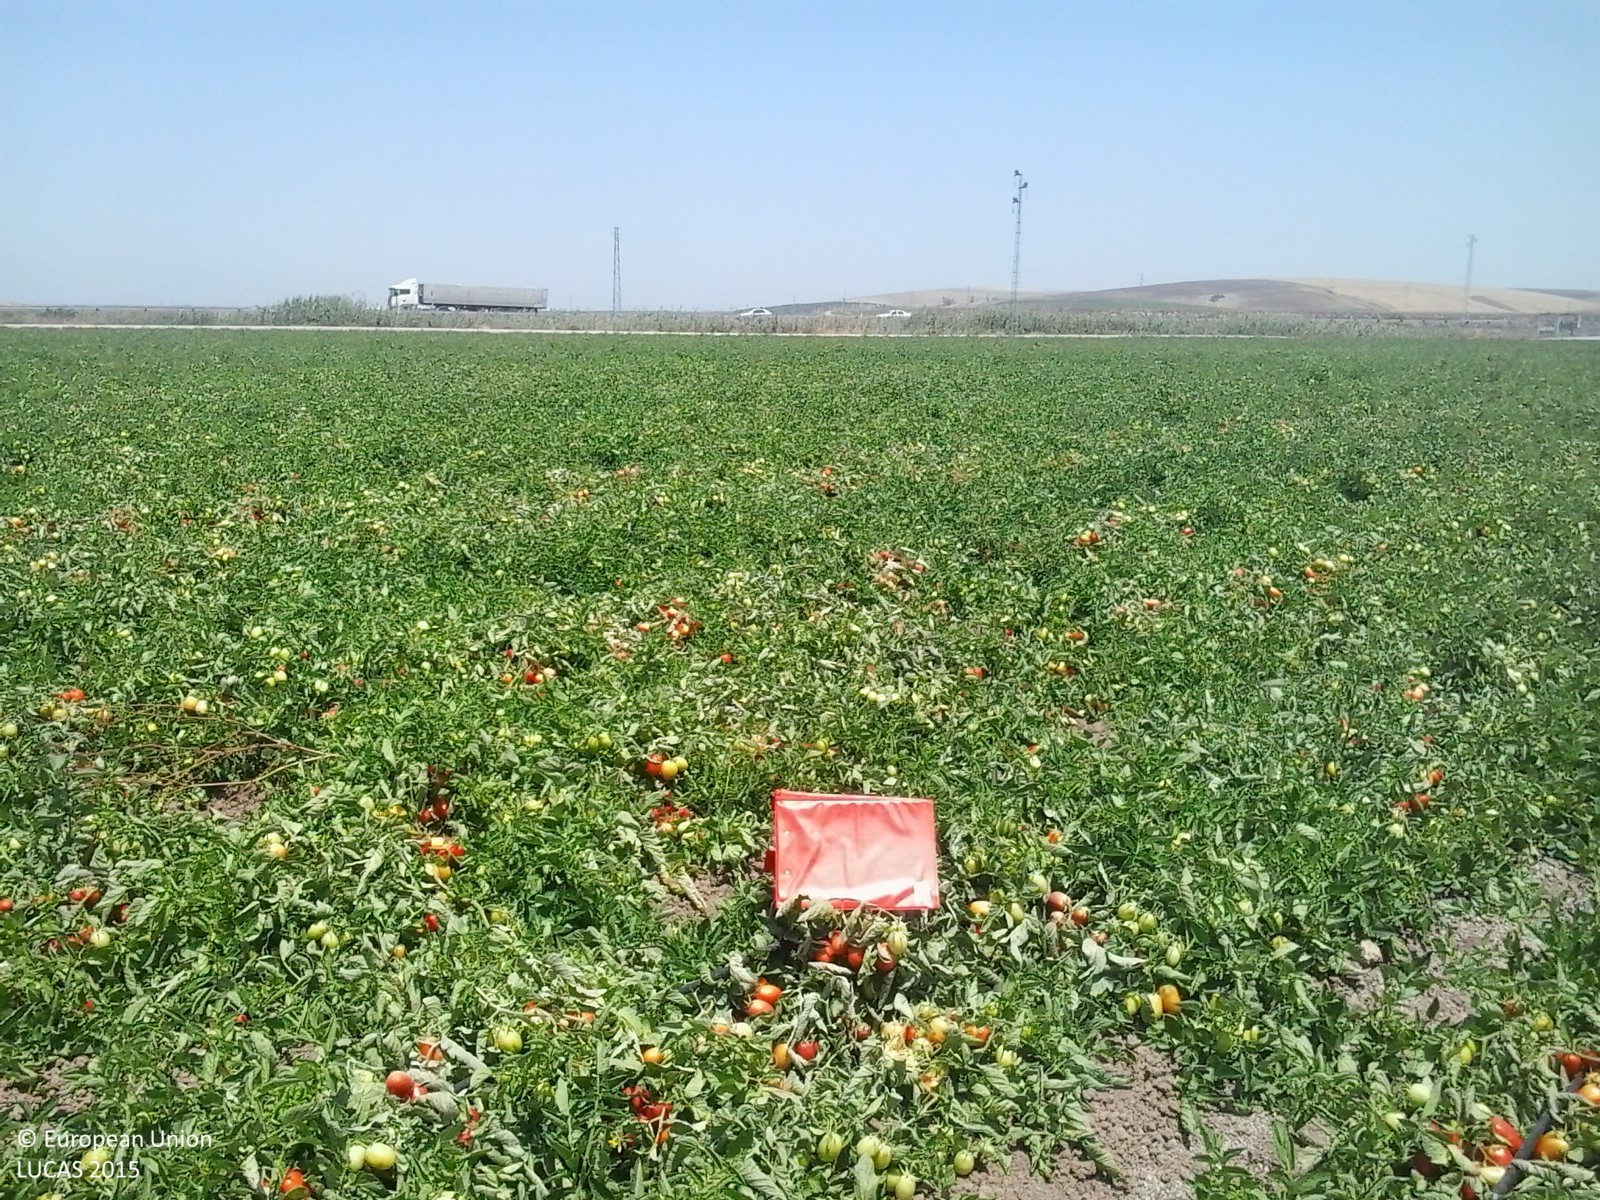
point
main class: Cropland
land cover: Tomatoes
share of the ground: > 75 %
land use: Agriculture (excluding fallow land and kitchen gardens)
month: July
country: ES
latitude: 36.9556
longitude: -5.9964
